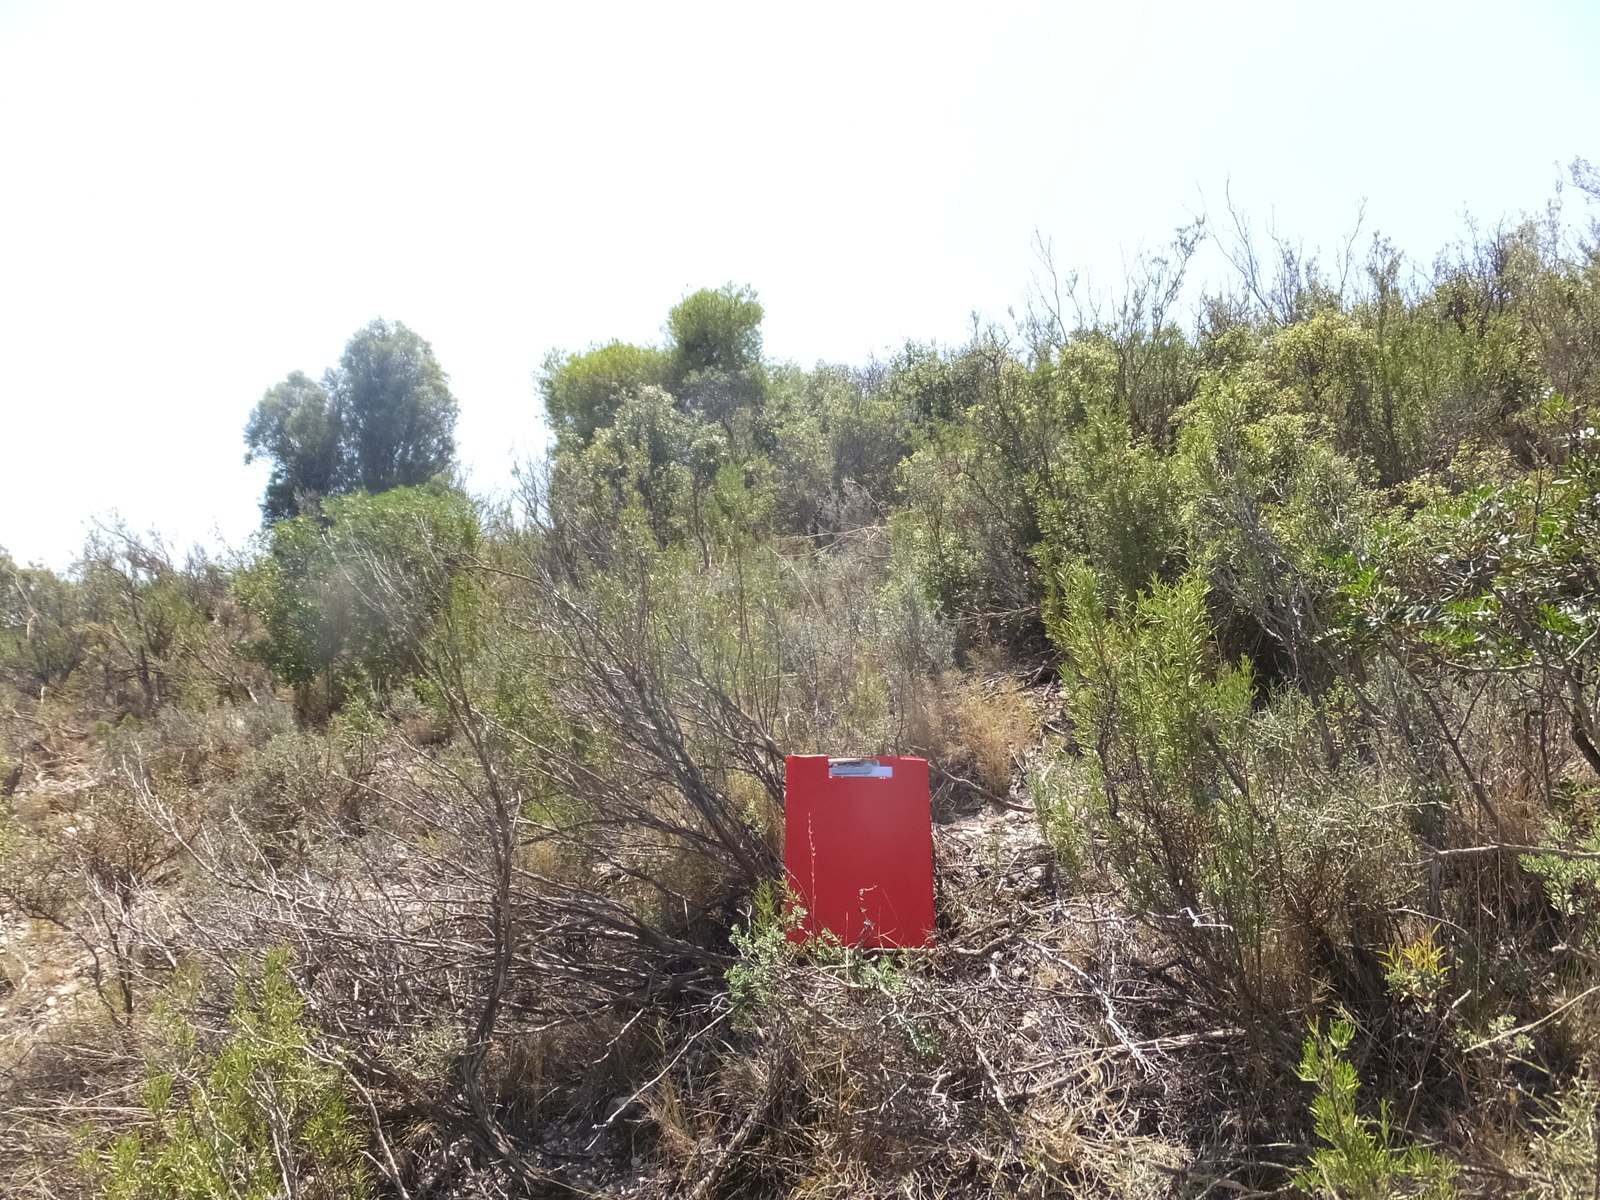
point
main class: Shrubland
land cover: Shrubland with sparse tree cover
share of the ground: > 75 %
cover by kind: shrubs 70 %, herbaceous plants 25 %, coniferous forest trees 5 %
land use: Semi-natural and natural areas not in use
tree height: < 5 m
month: August
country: ES
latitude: 41.4392
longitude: 0.0887
